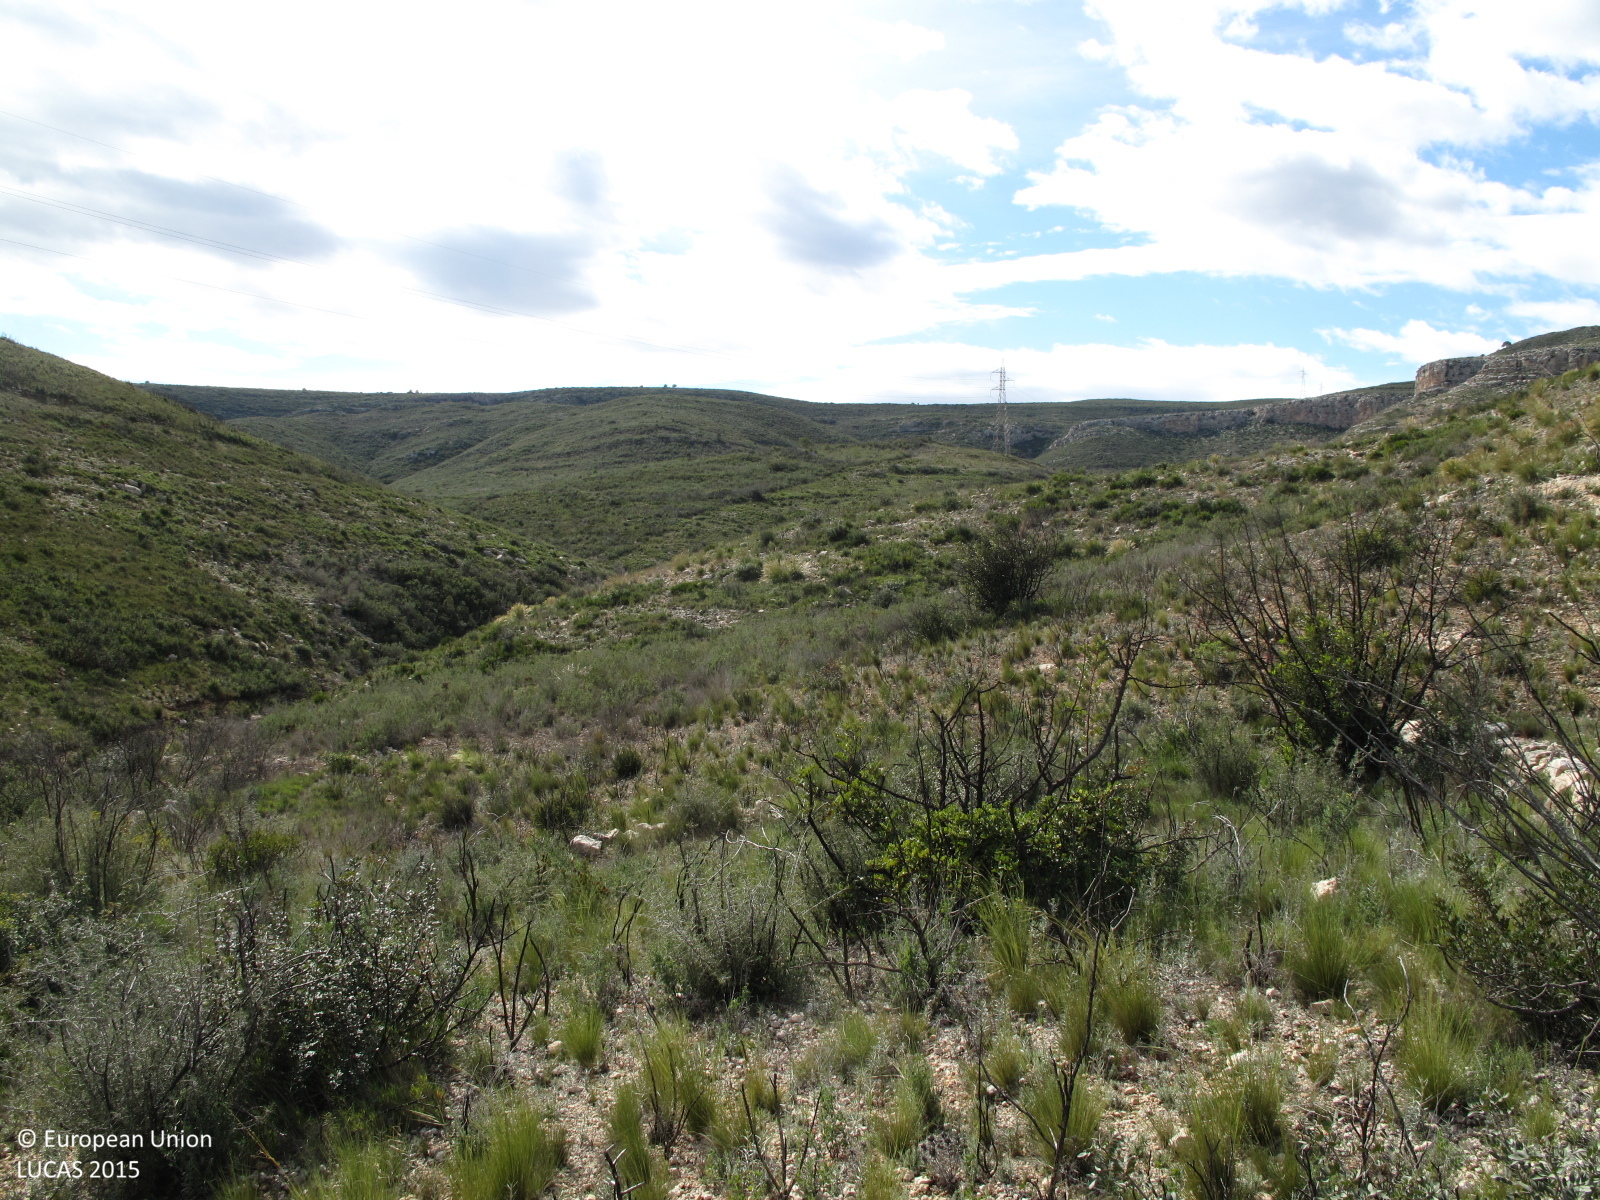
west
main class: Shrubland
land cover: Shrubland without tree cover
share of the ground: 50 - 75 %
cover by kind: shrubs 50 %, herbaceous plants 25 %, consolidated bare surface 25 %
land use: Semi-natural and natural areas not in use
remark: Burnt area
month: March
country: ES
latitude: 39.1949
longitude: -0.6362
